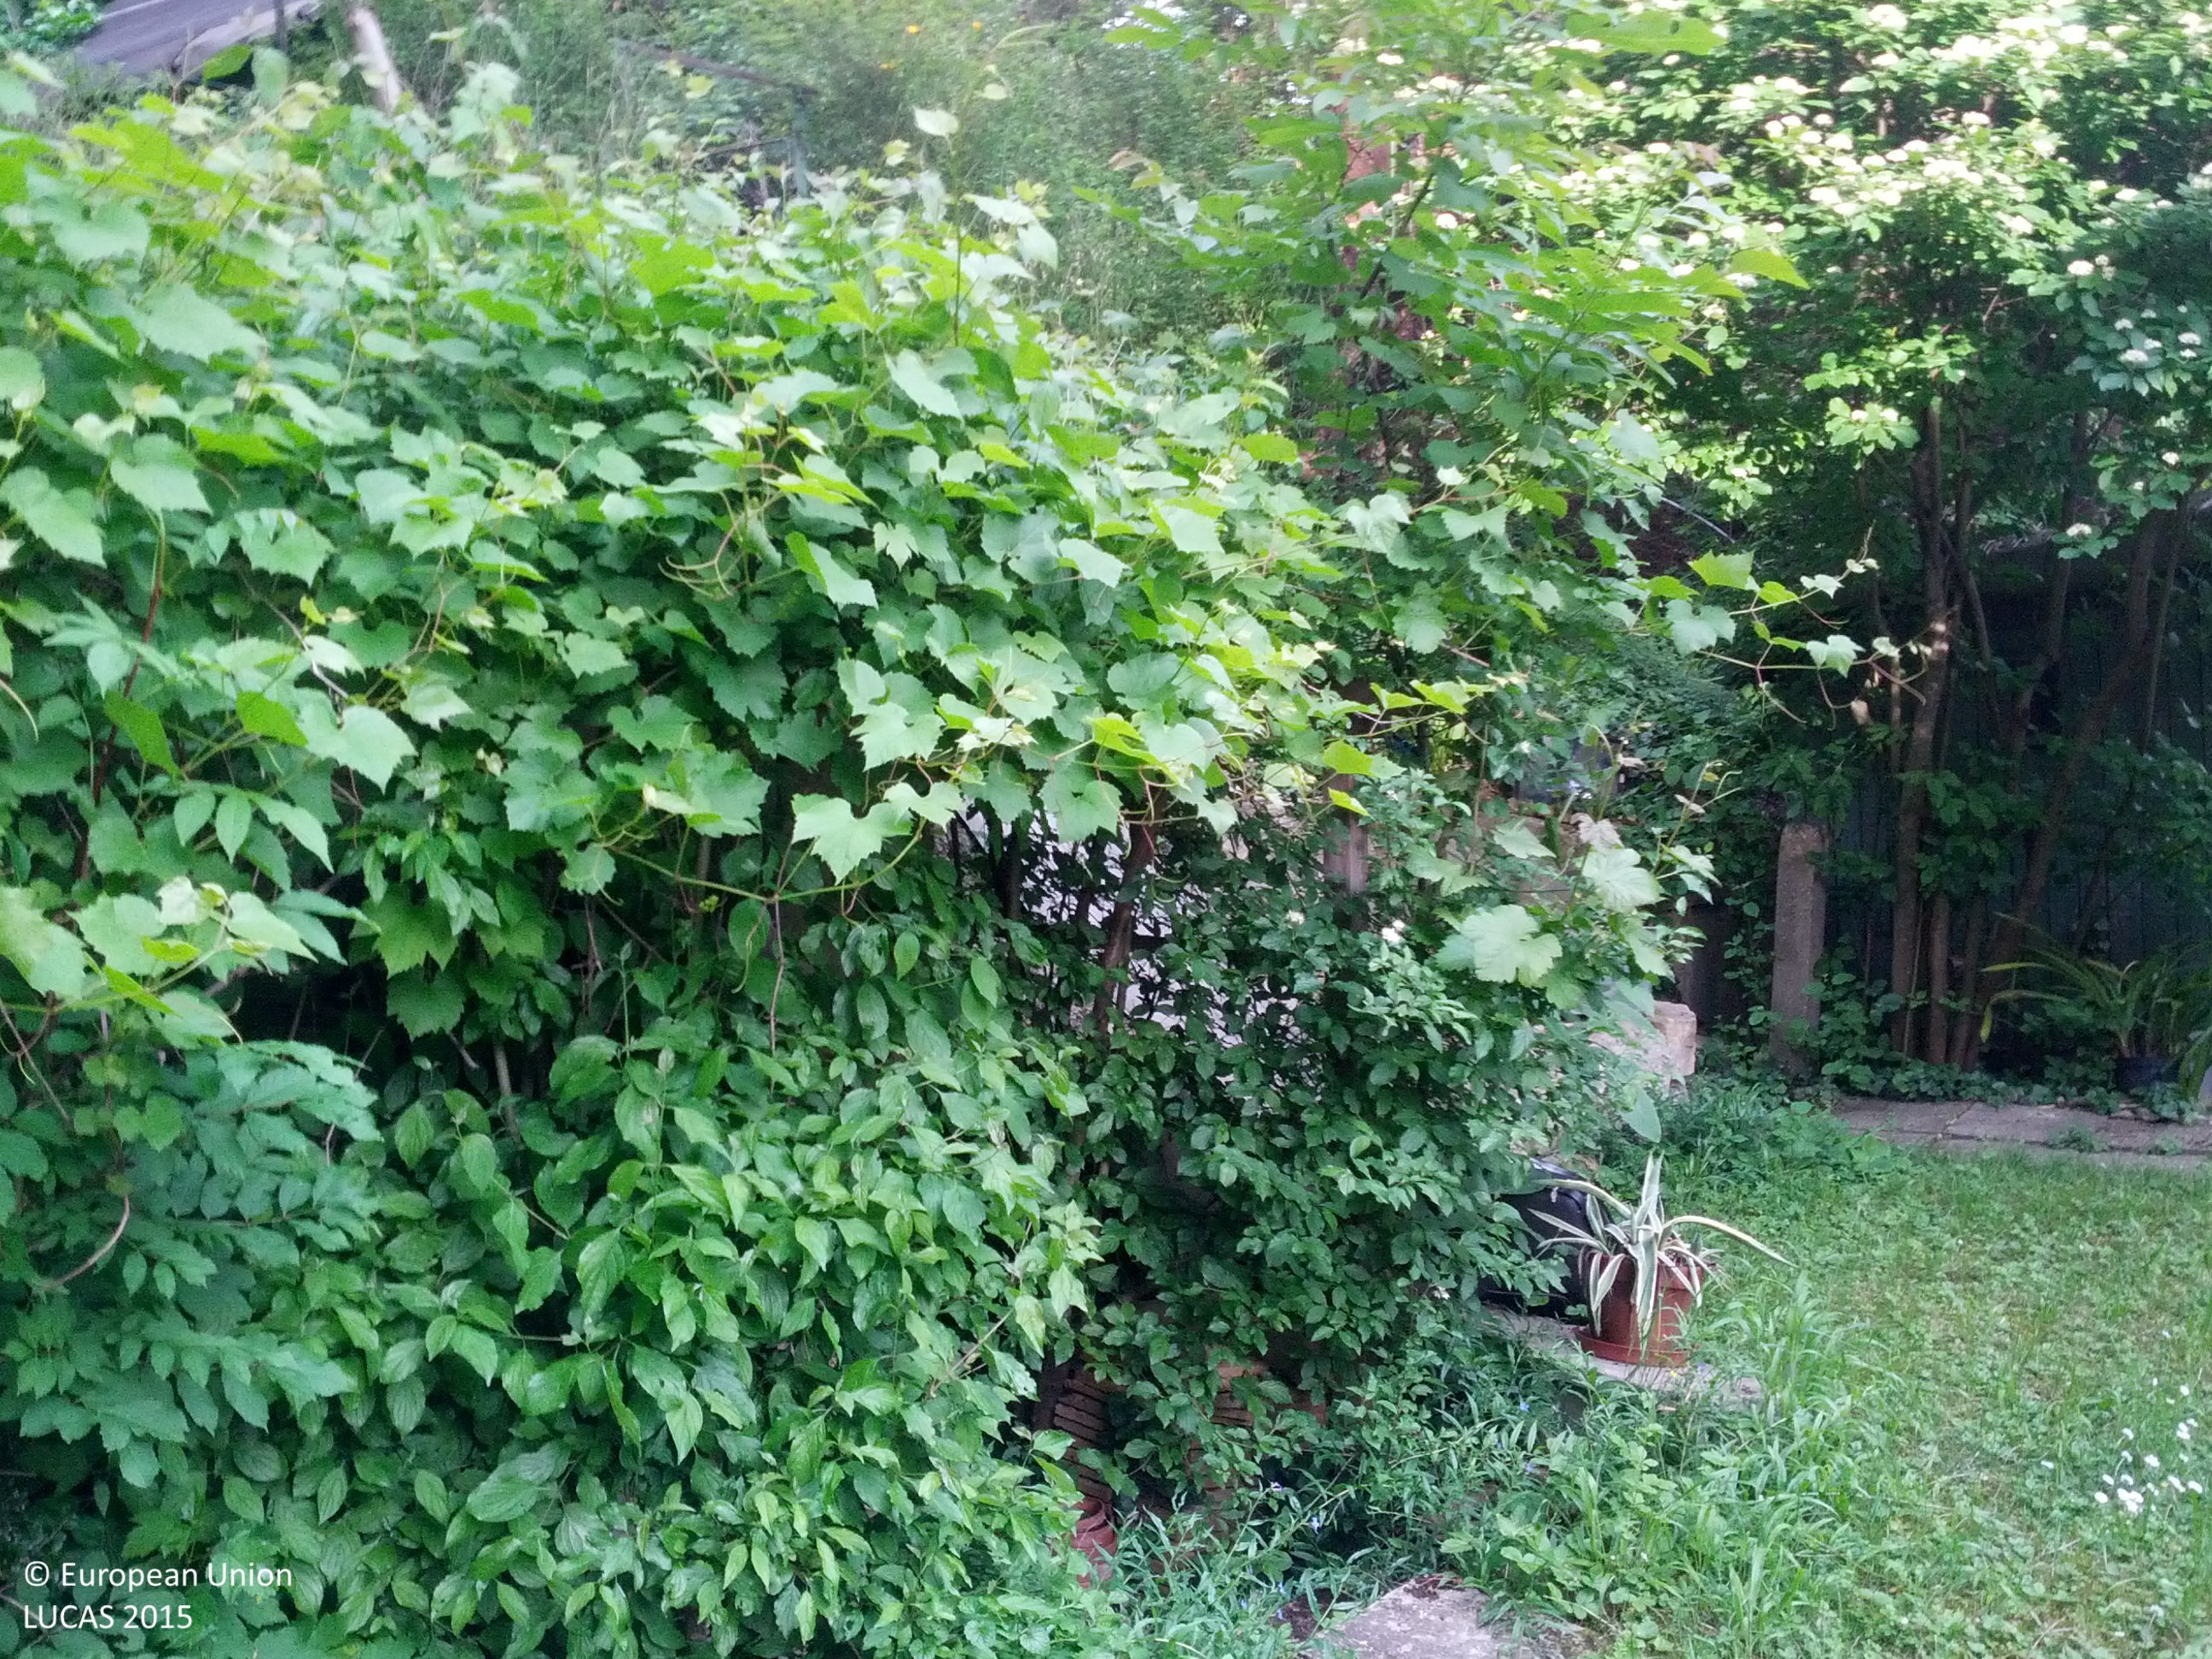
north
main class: Grassland
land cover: Grassland with sparse tree/shrub cover
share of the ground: > 75 %
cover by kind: herbaceous plants 85 %, shrubs 10 %, broadleaved forest trees 5 %
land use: Residential
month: May
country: AT
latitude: 48.2960
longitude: 16.2999
